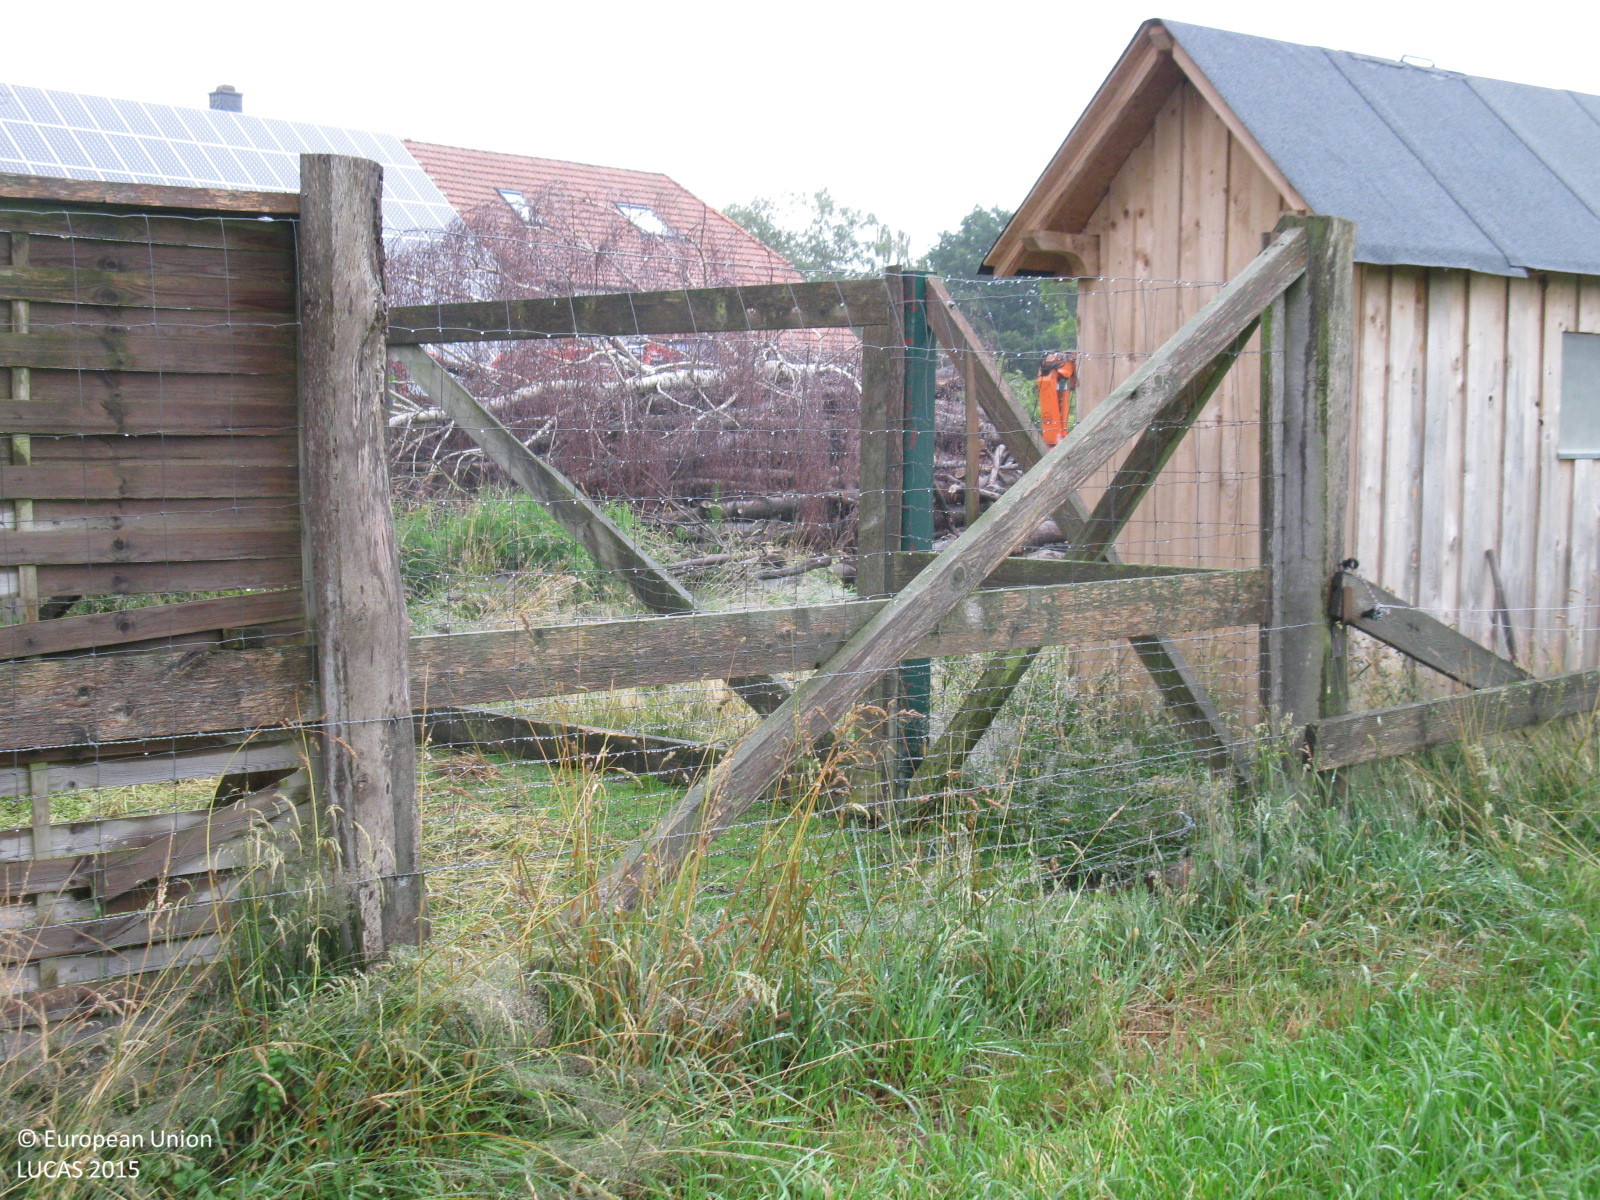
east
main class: Grassland
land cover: Grassland without tree/shrub cover
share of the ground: > 75 %
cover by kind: herbaceous plants 100 %
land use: Agriculture (excluding fallow land and kitchen gardens)
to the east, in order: Grassland without tree/shrub cover; Artificial constructions in urban areas; Grassland without tree/shrub cover
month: July
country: DE
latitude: 53.2772
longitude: 7.9761
